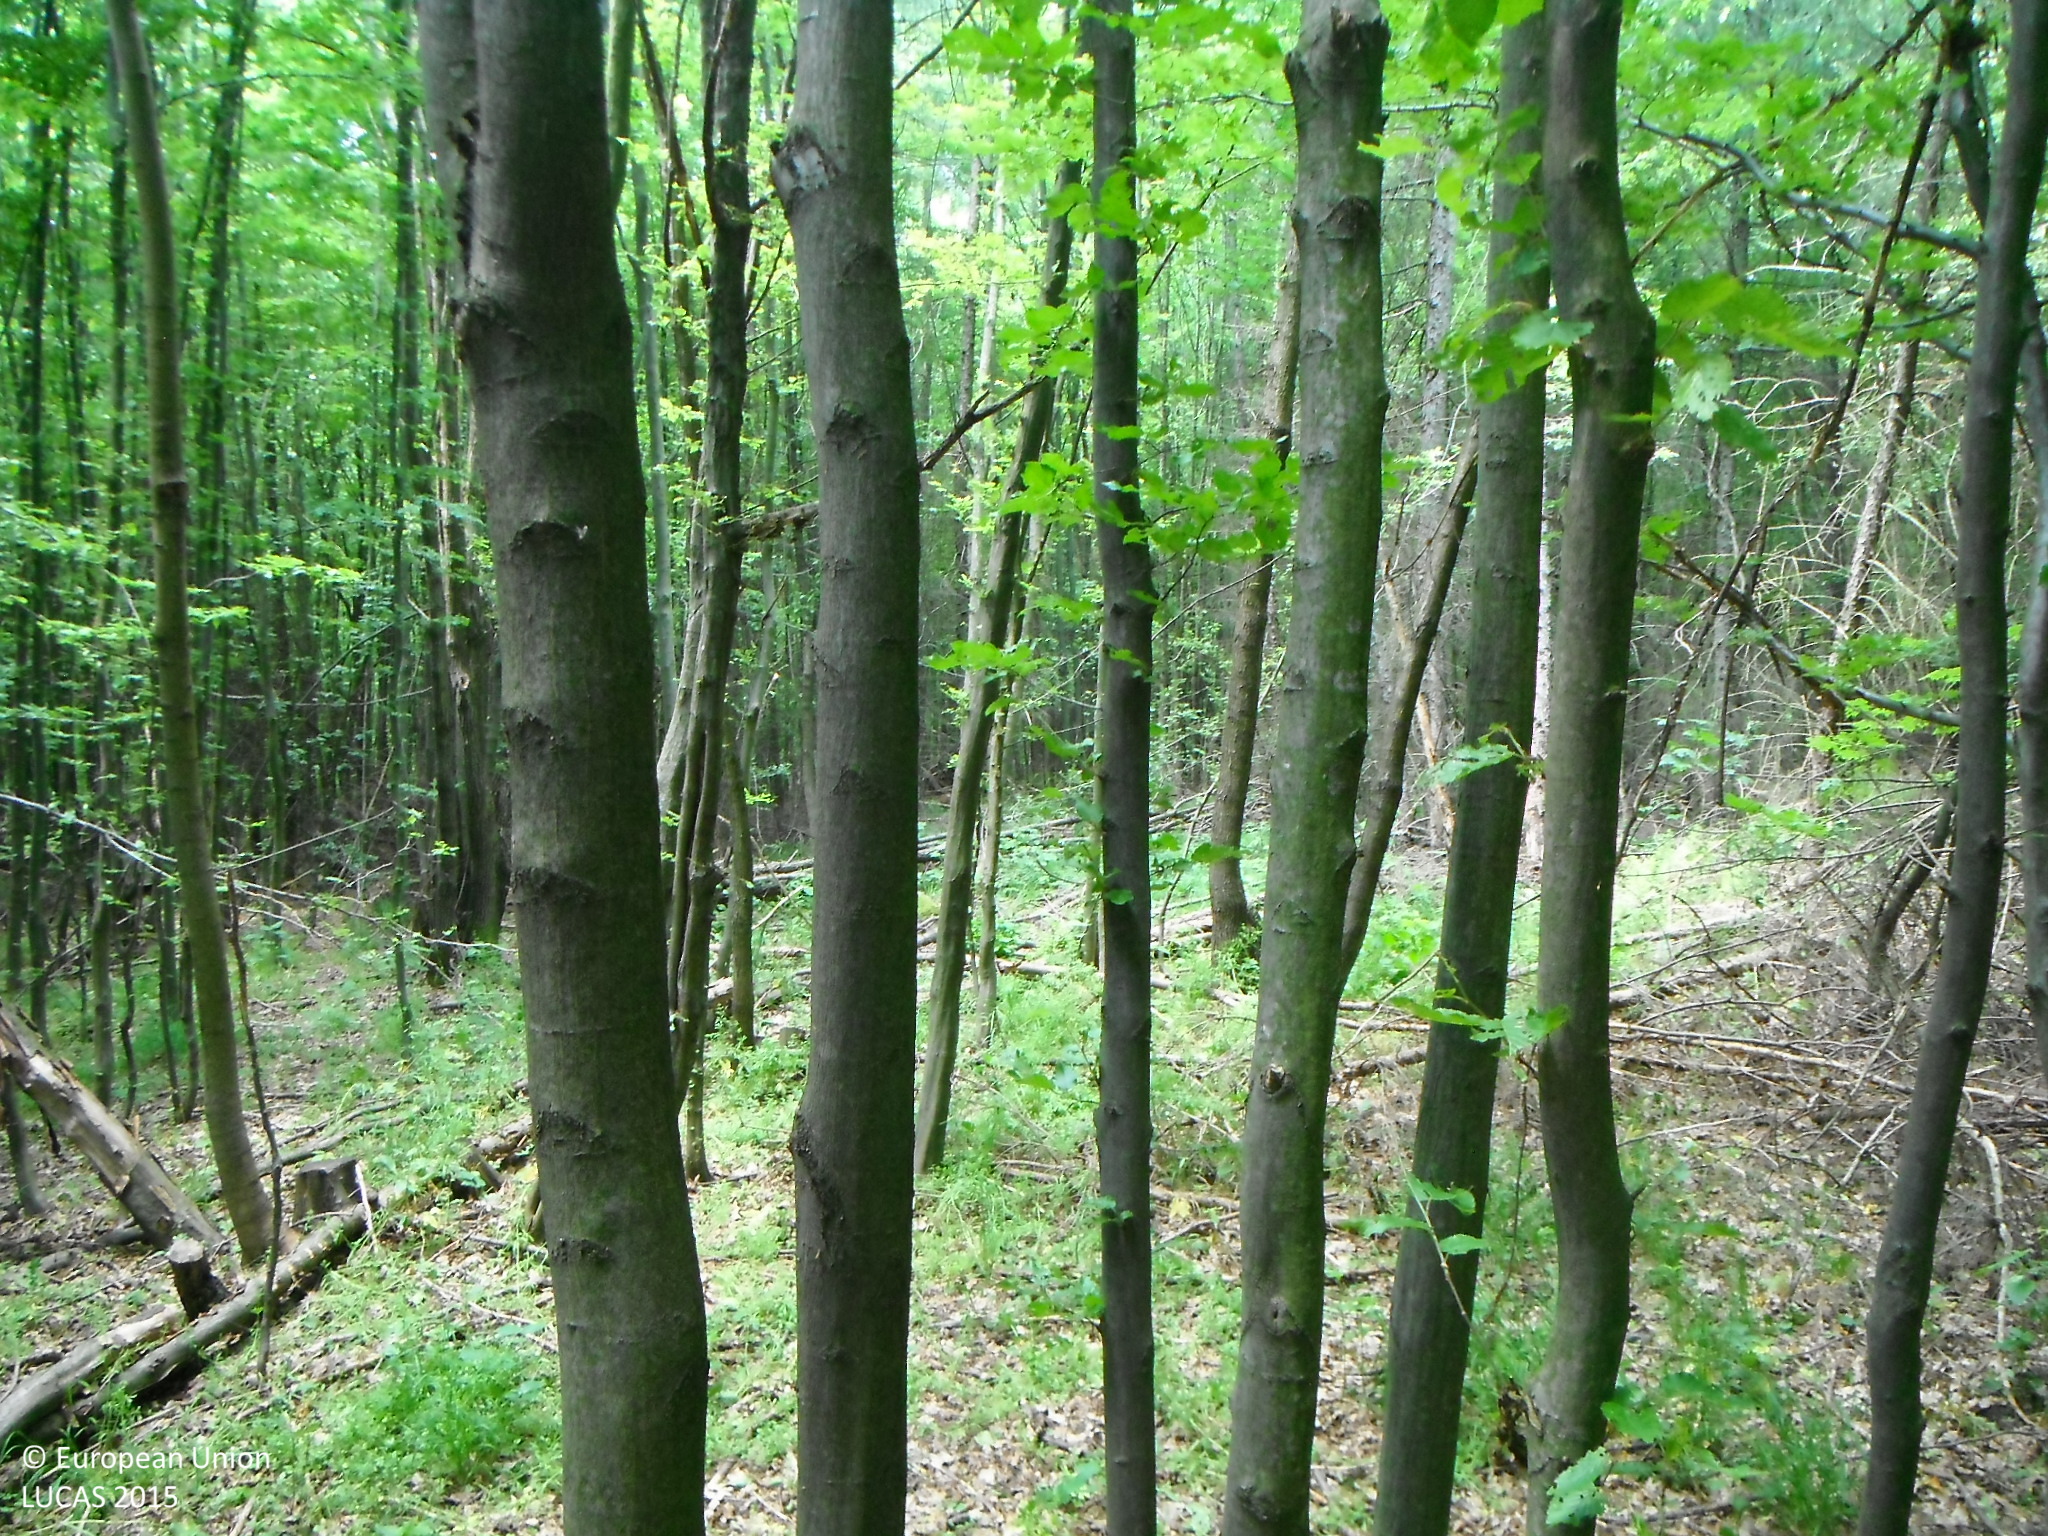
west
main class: Woodland
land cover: Broadleaved woodland
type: mesophytic deciduous forest
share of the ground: > 75 %
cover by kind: broadleaved forest trees 100 %
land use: Forestry
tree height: > 5 m
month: May
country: SK
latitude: 48.3864
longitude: 18.9185
